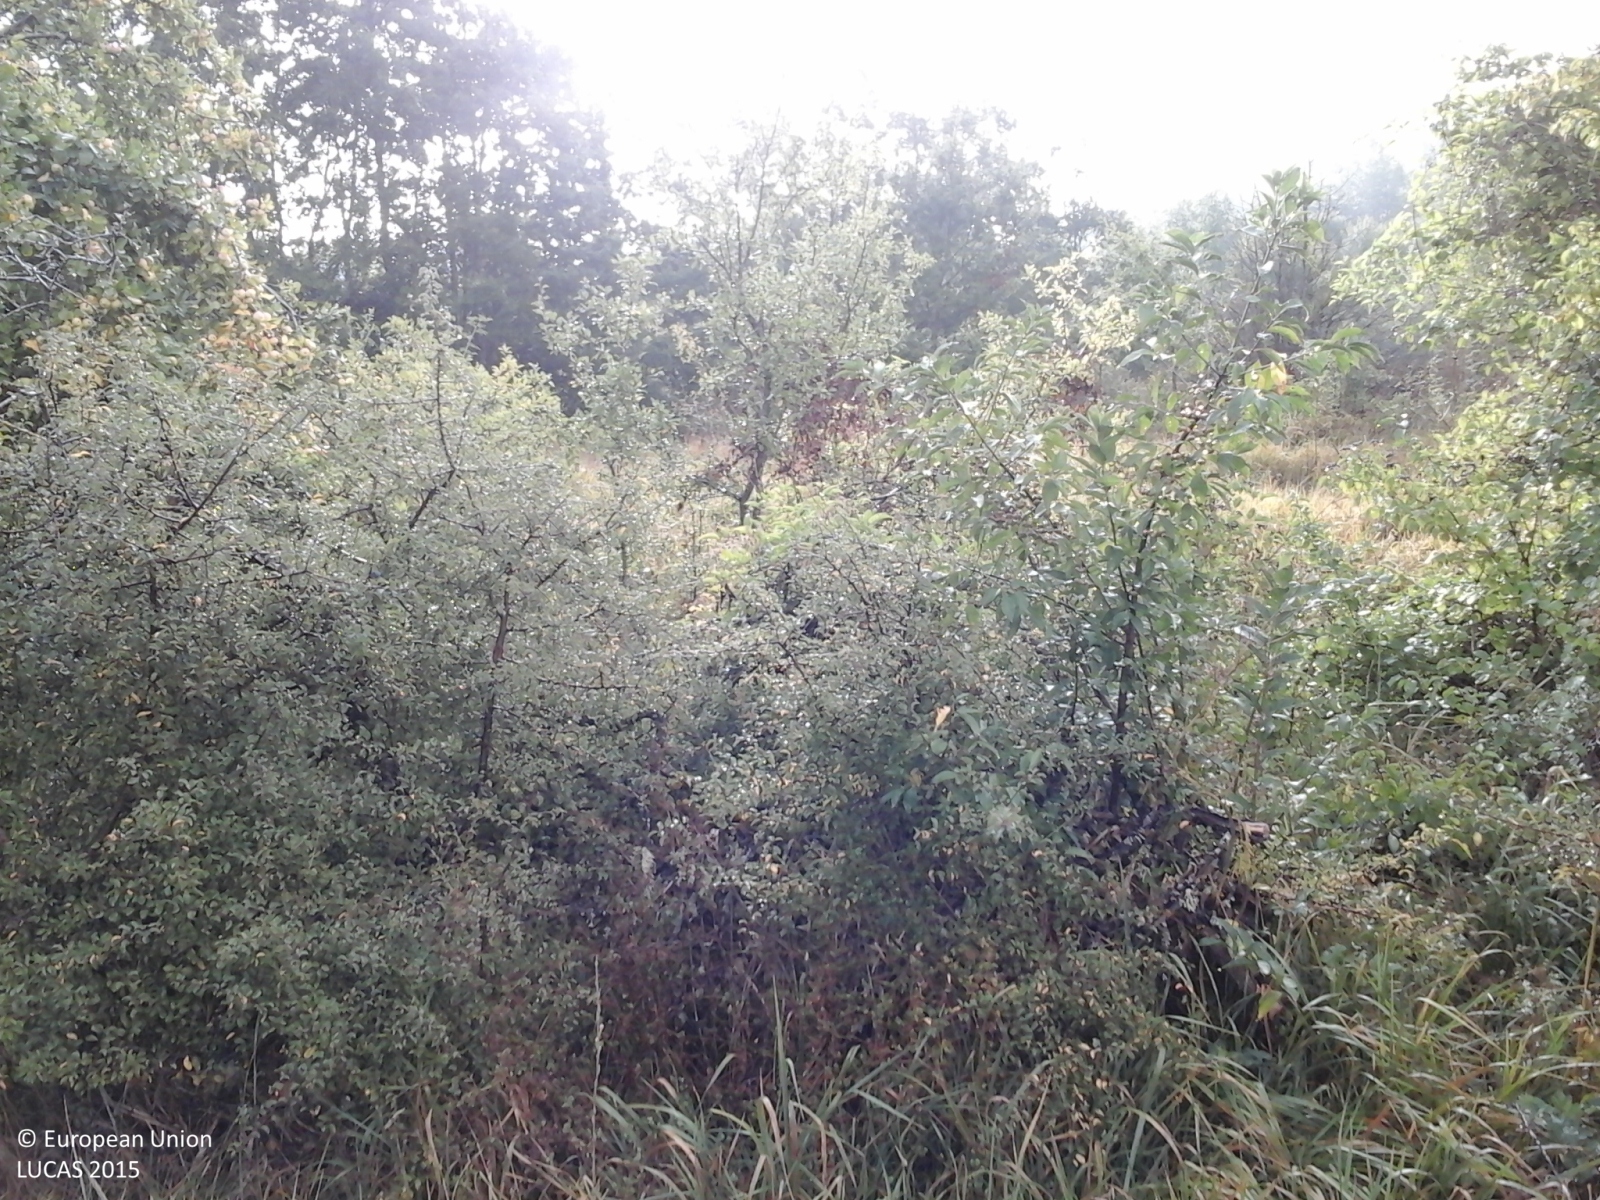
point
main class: Woodland
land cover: Broadleaved woodland
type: thermophilous deciduous forest
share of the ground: > 75 %
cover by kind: broadleaved forest trees 75 %, shrubs 15 %, herbaceous plants 10 %
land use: Forestry
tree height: > 5 m
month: September
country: IT
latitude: 41.7454
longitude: 14.3741
